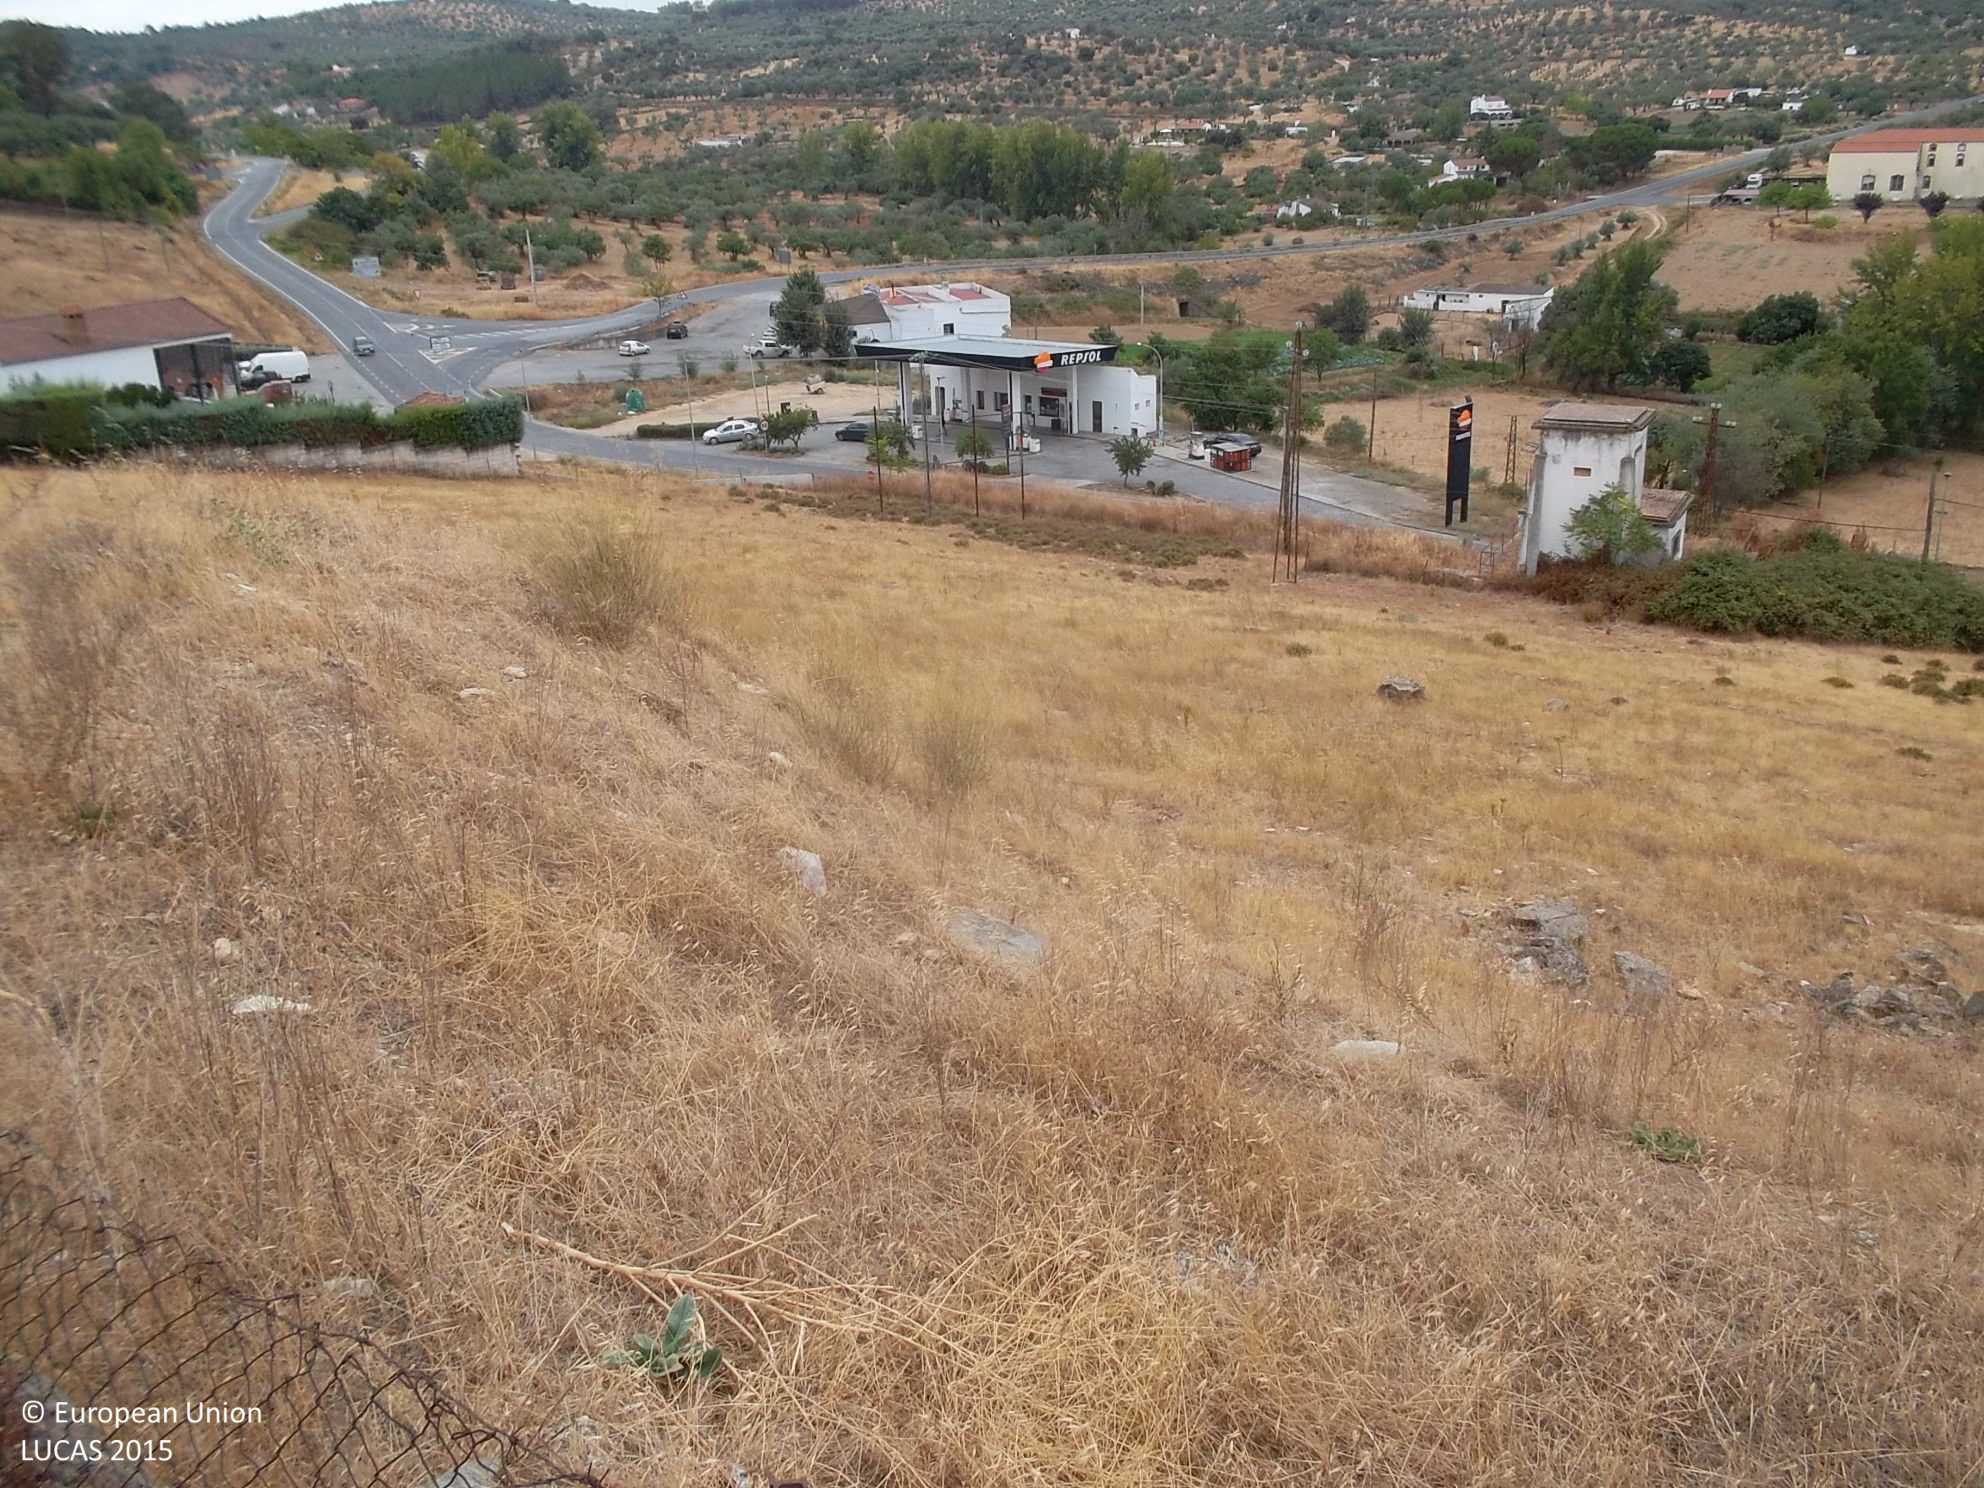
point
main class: Grassland
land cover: Grassland without tree/shrub cover
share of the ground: > 75 %
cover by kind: herbaceous plants 100 %
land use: Semi-natural and natural areas not in use
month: September
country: ES
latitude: 38.1171
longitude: -6.5288
